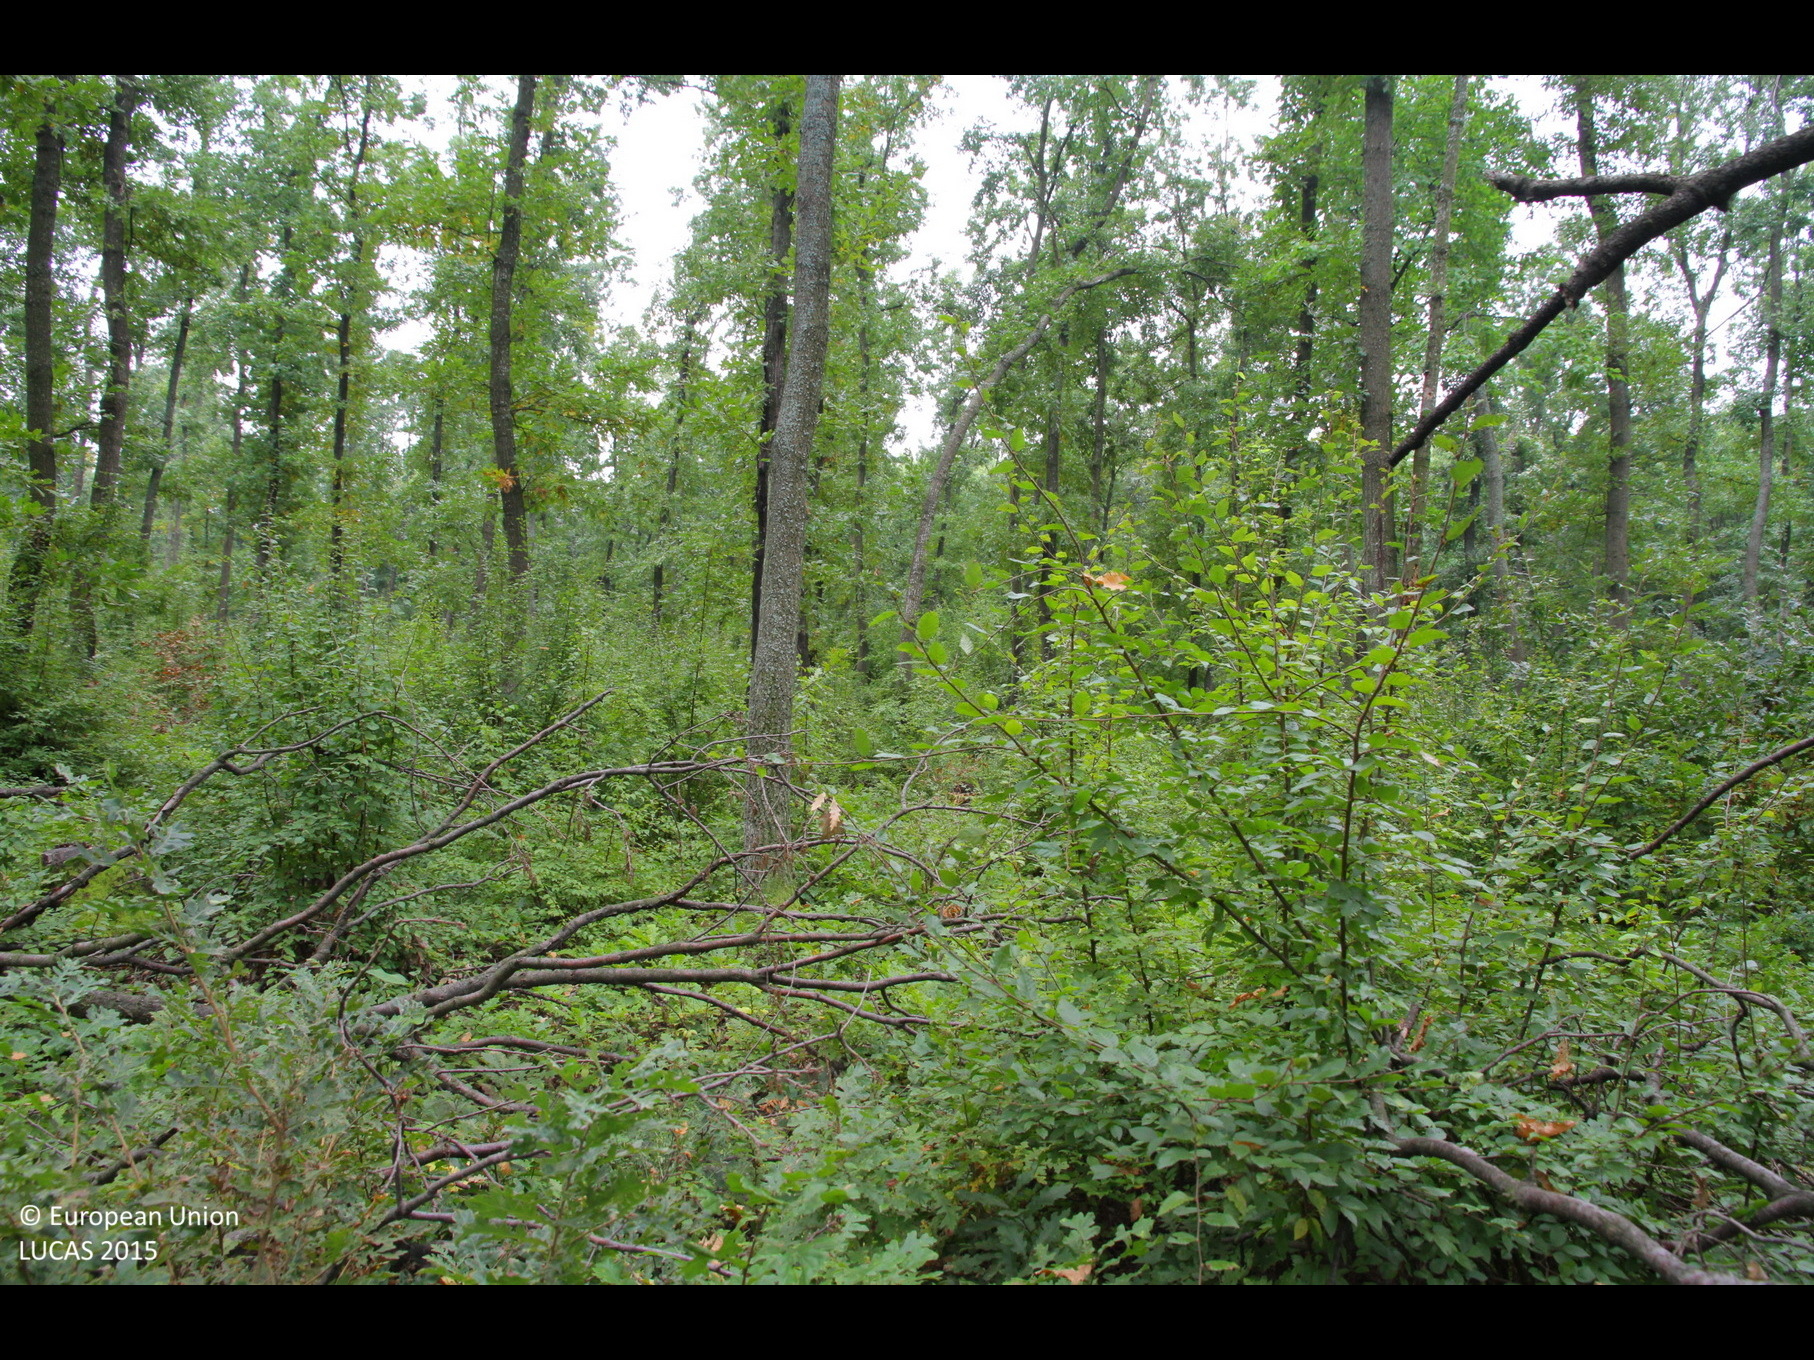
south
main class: Woodland
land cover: Broadleaved woodland
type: mesophytic deciduous forest
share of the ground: > 75 %
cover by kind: broadleaved forest trees 95 %, shrubs 5 %
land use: Forestry
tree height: > 5 m
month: October
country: BG
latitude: 43.5150
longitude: 27.0543
